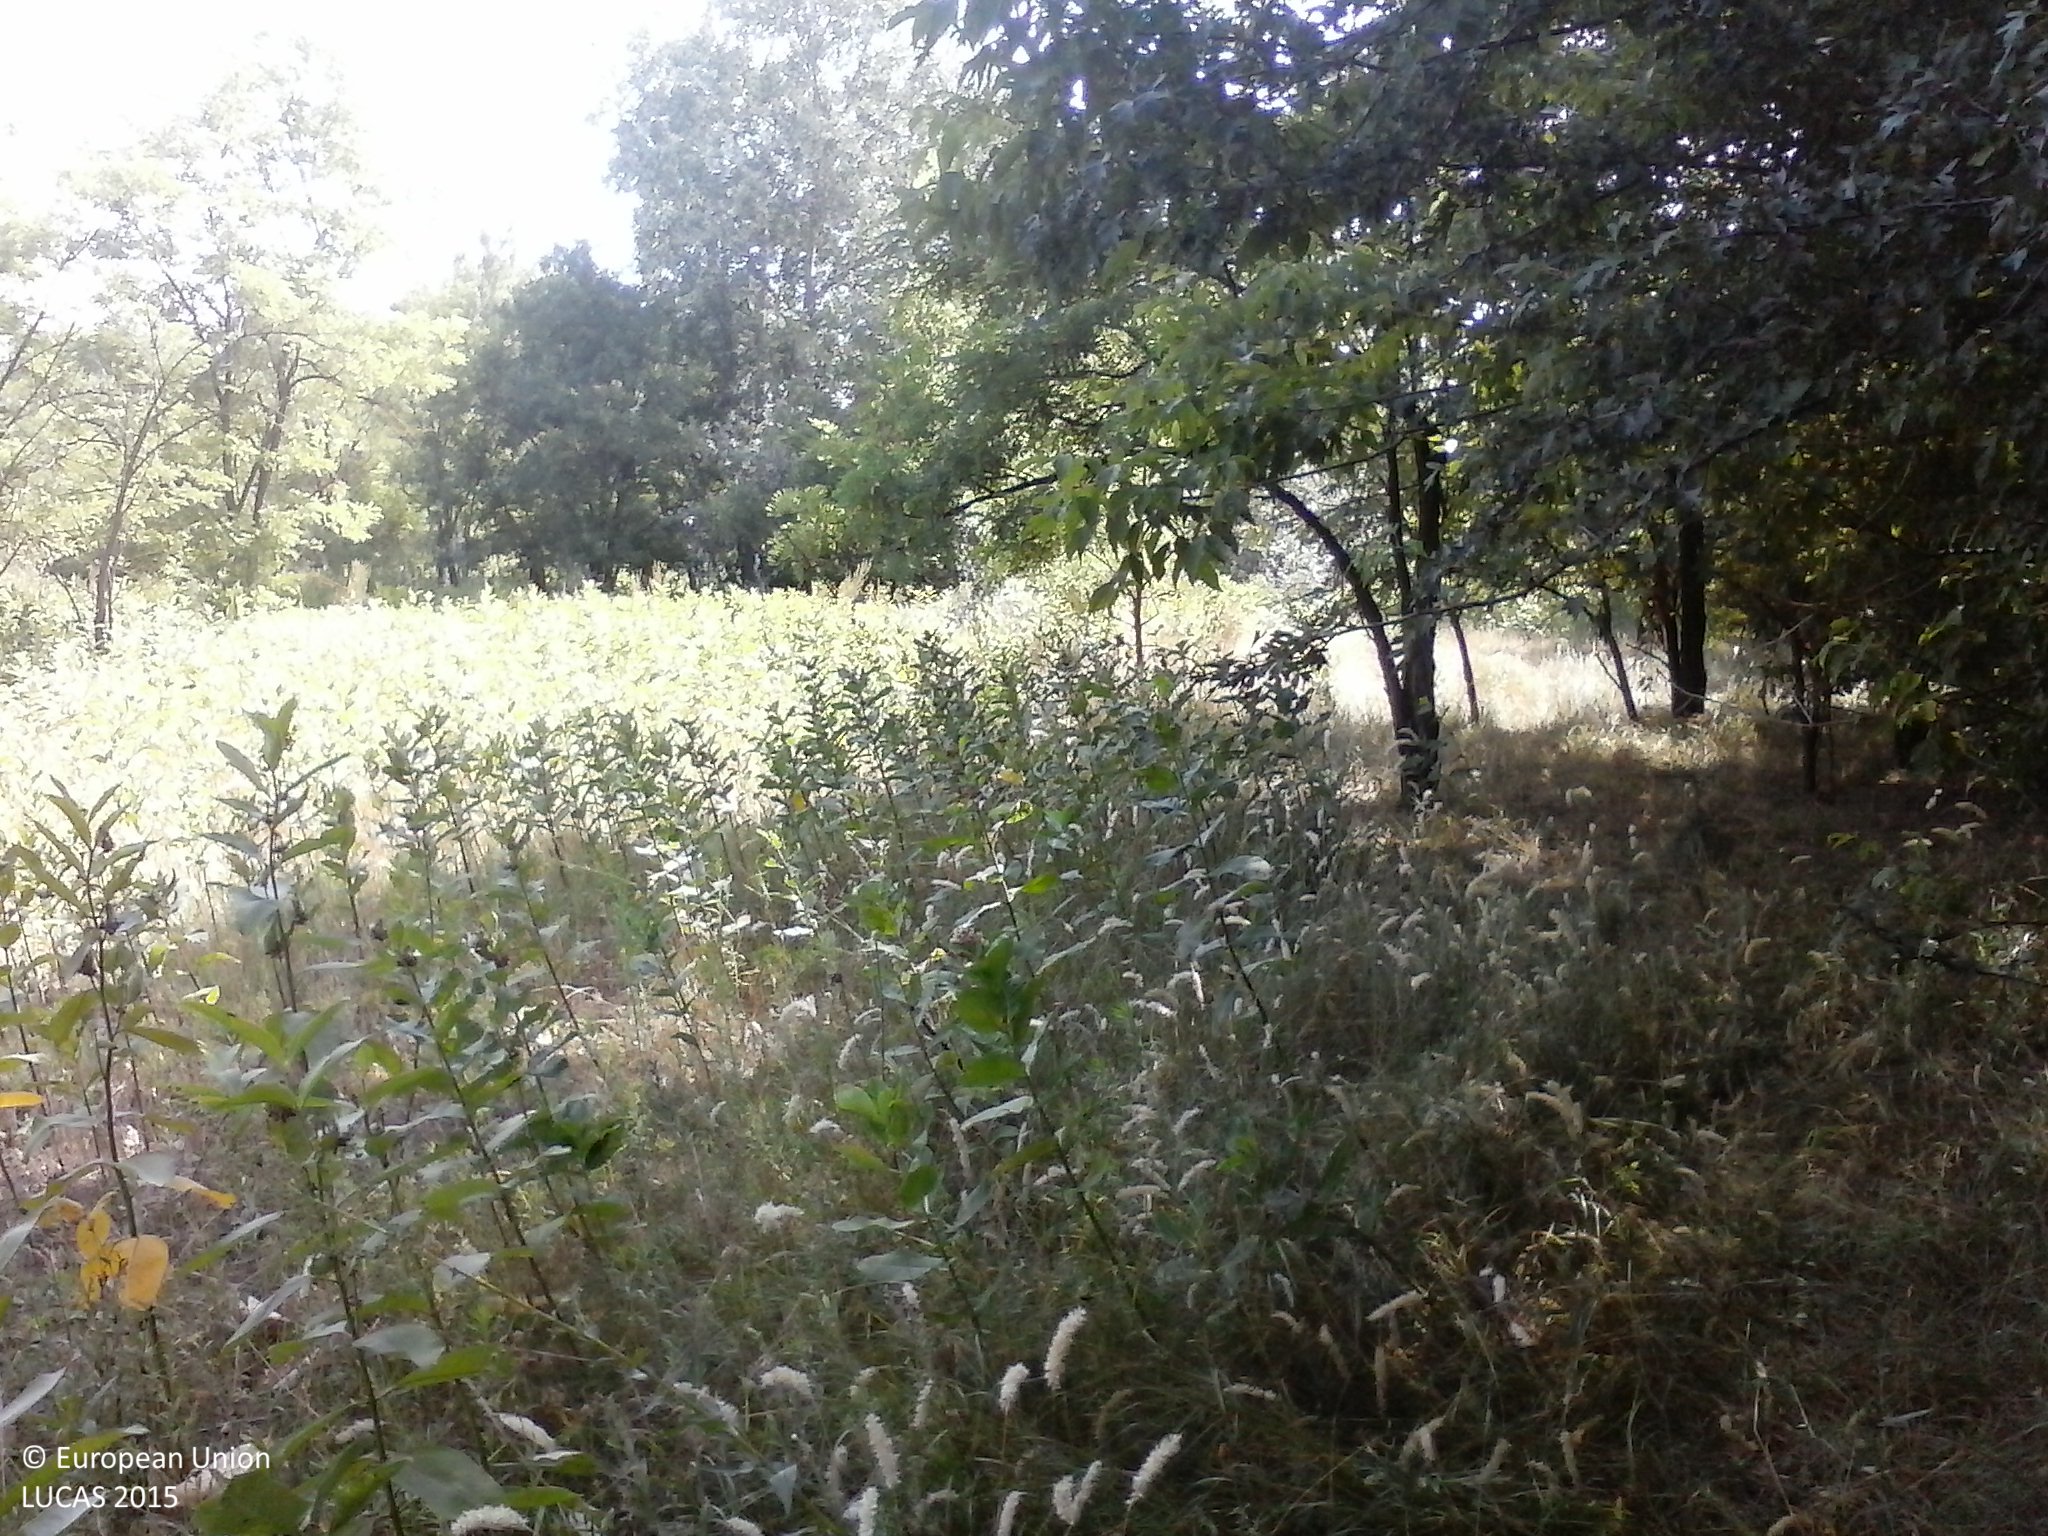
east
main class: Woodland
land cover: Broadleaved woodland
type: mesophytic deciduous forest
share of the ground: 50 - 75 %
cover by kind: broadleaved forest trees 70 %, shrubs 15 %, herbaceous plants 15 %
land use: Semi-natural and natural areas not in use
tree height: > 5 m
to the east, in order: Broadleaved woodland; Tracks; Spontaneously vegetated surfaces; Fences; Grass margins; Artificial constructions in urban areas; Spontaneously vegetated surfaces; Broadleaved woodland
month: July
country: HU
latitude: 46.5705
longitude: 19.6082
